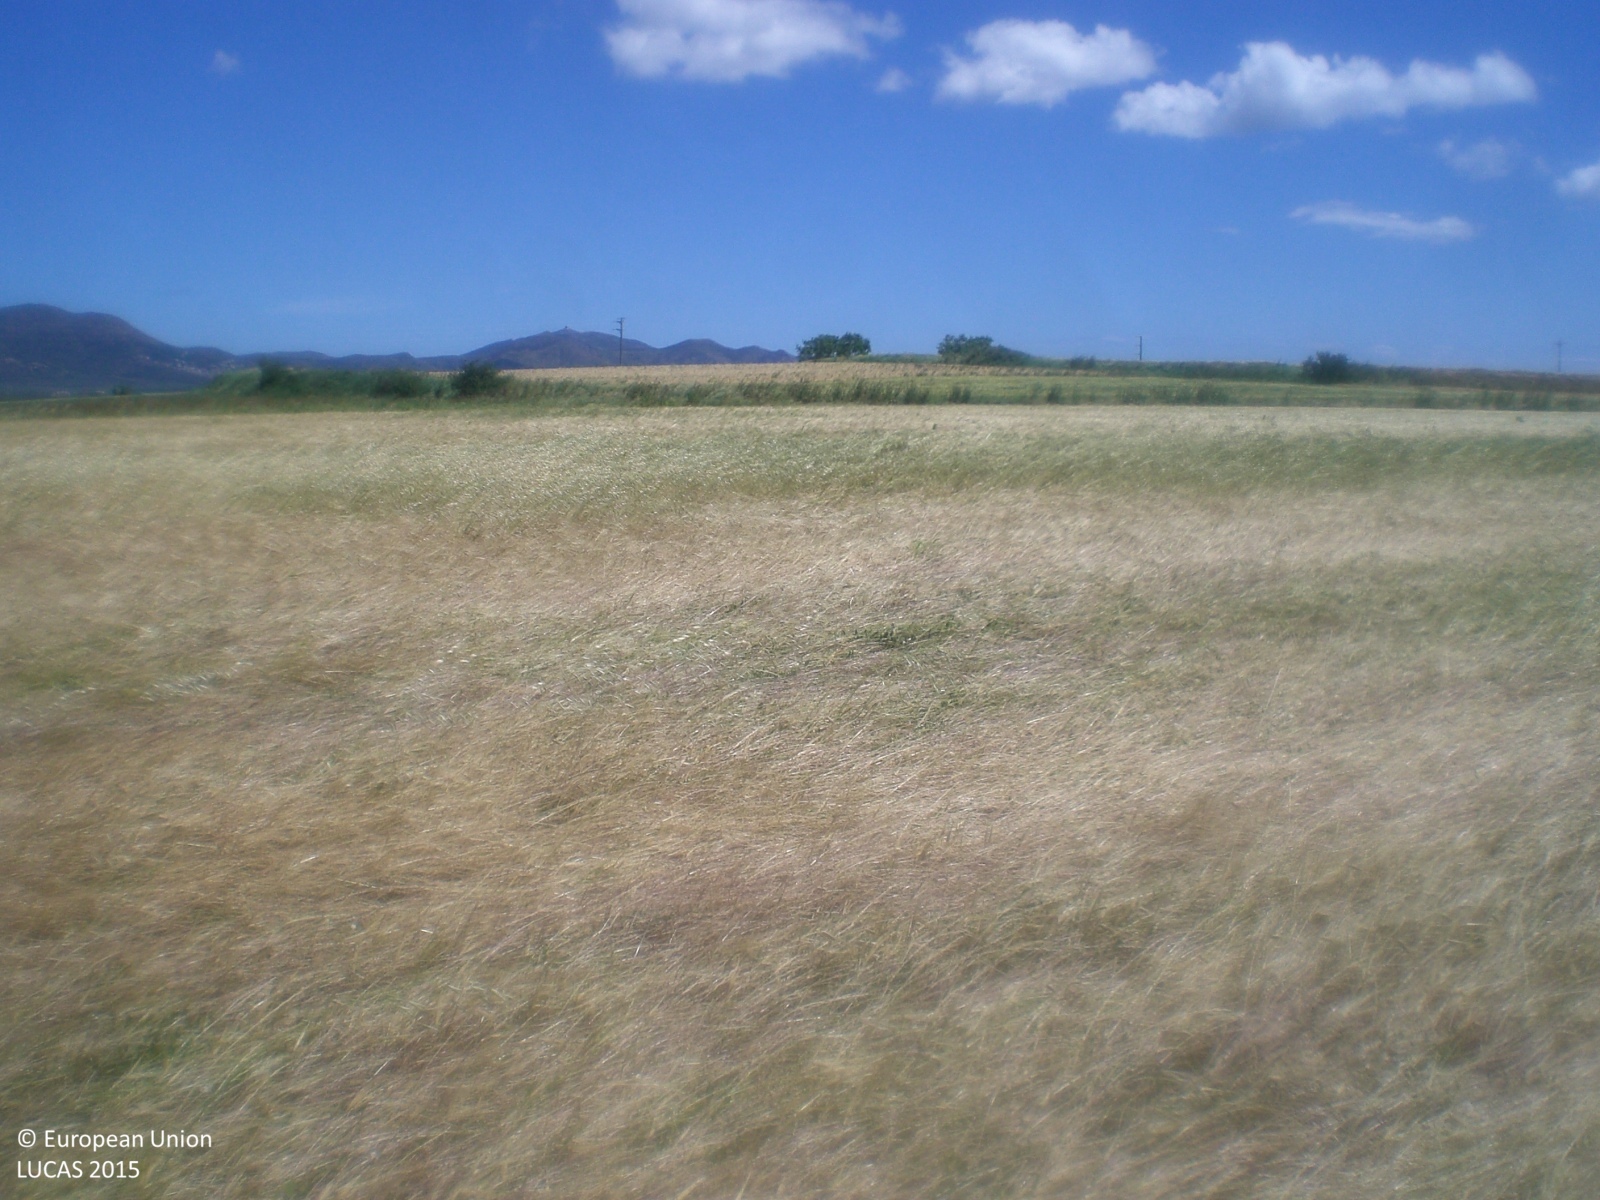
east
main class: Cropland
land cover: Barley
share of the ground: > 75 %
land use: Agriculture (excluding fallow land and kitchen gardens)
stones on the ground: > 50 %
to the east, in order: Barley; Grassland without tree/shrub cover; Barley; Grass margins; Barley; Tracks; Dry pulses
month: May
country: ES
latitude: 42.2713
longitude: 3.0670
